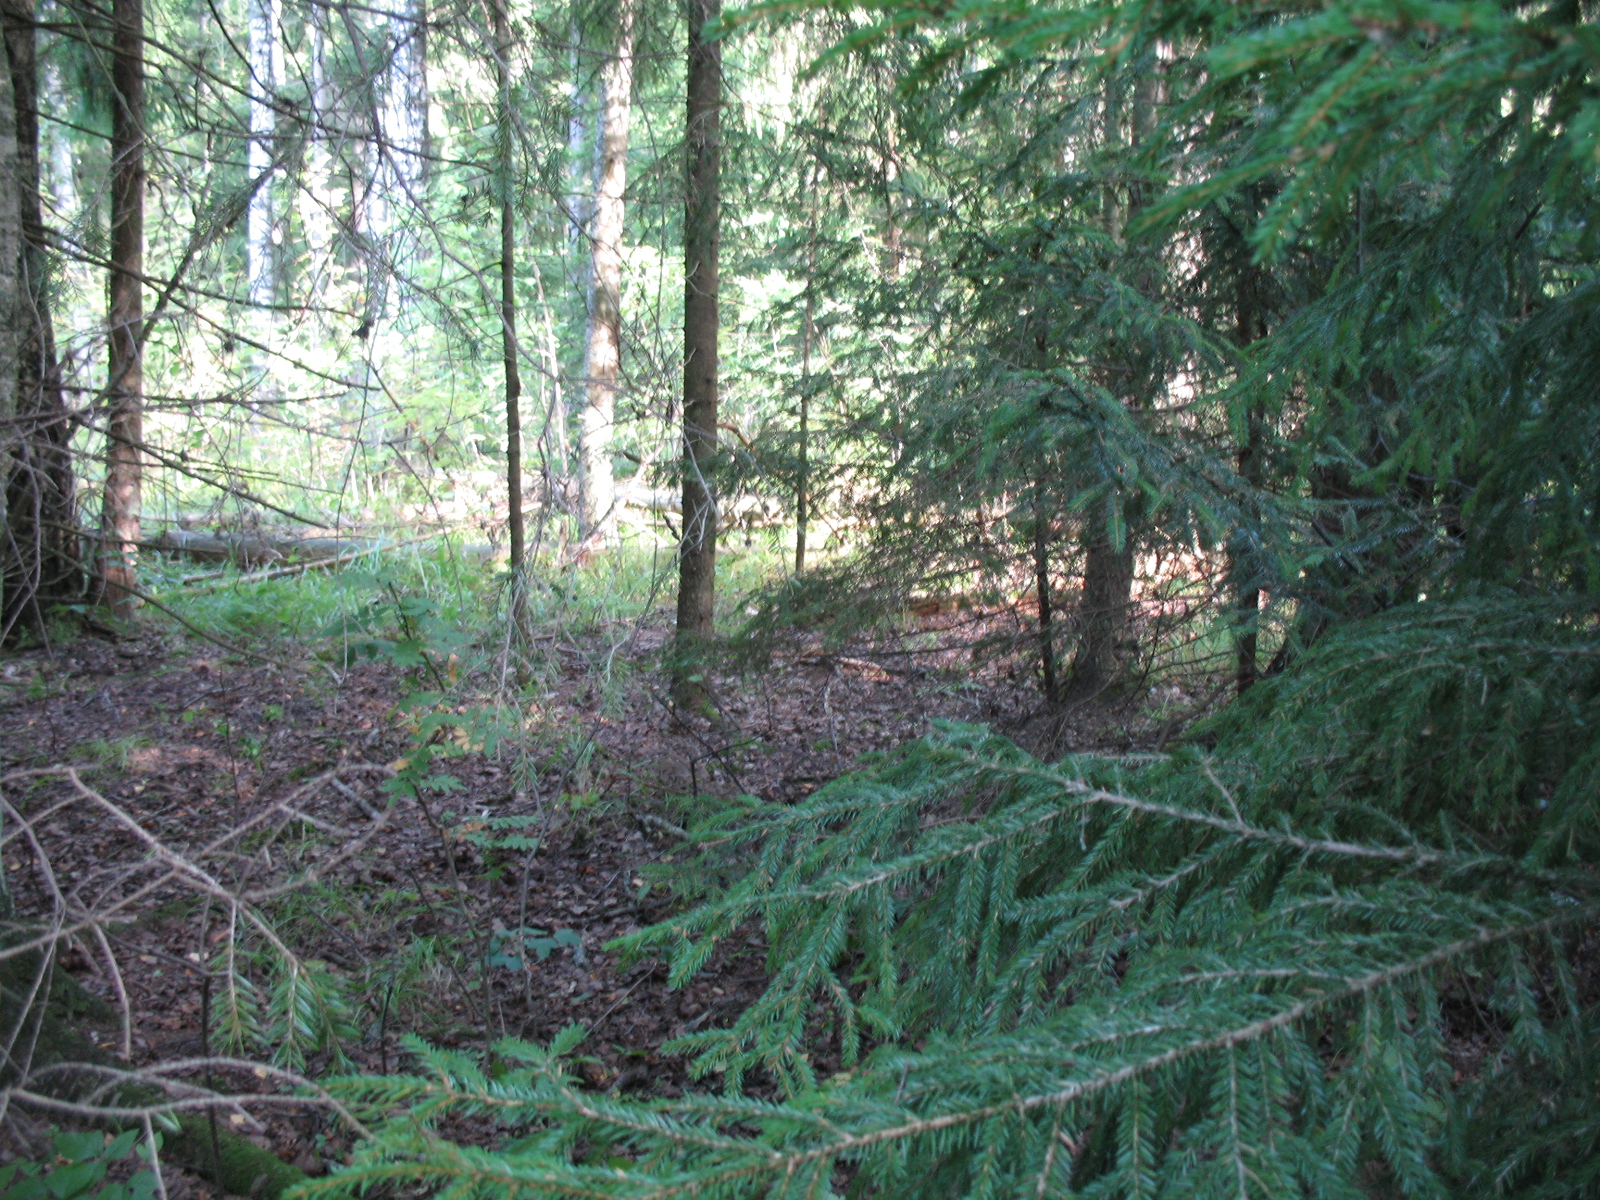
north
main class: Woodland
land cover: Spruce dominated mixed woodland
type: hemiboreal forest and nemoral coniferous forest and mixed broadleaved-coniferous forest
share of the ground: > 75 %
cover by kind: coniferous forest trees 40 %, broadleaved forest trees 40 %, shrubs 10 %, herbaceous plants 10 %
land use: Forestry
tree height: > 5 m
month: August
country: LV
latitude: 56.3317
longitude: 26.0008
